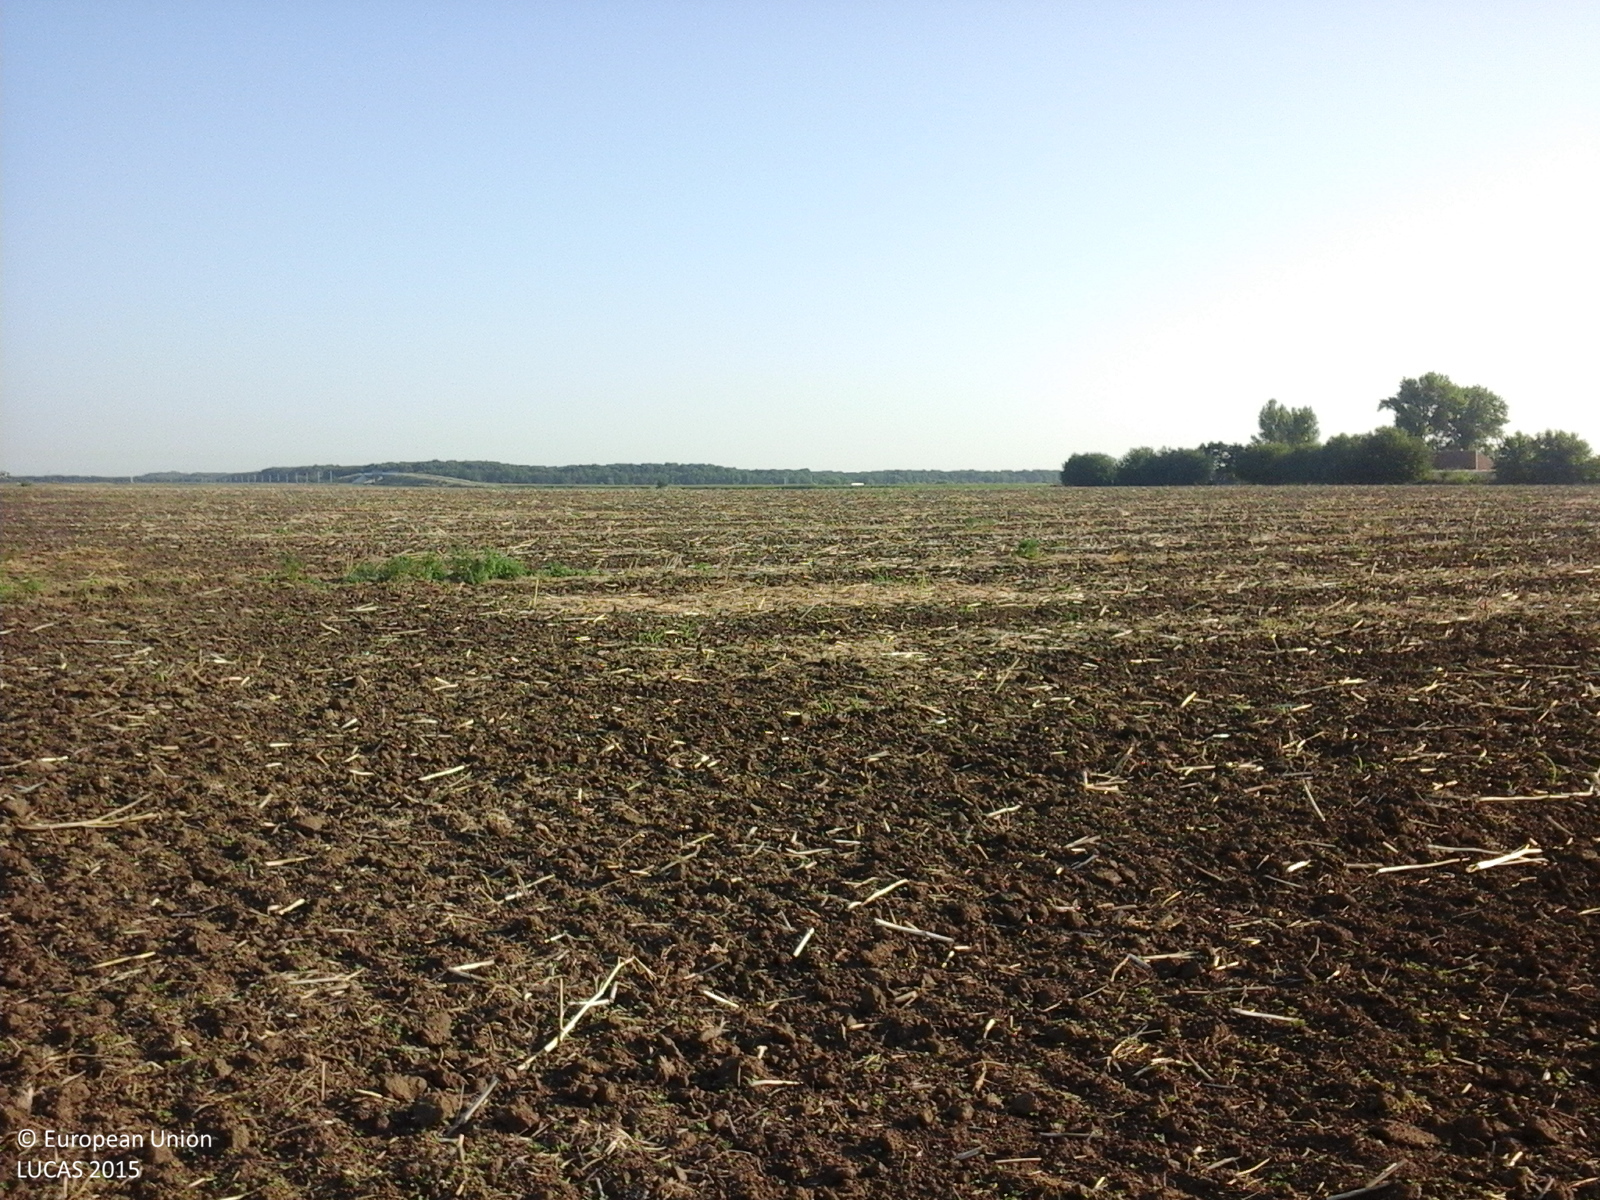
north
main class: Cropland
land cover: Rape and turnip rape
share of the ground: < 10 %
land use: Agriculture (excluding fallow land and kitchen gardens)
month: July
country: RO
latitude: 44.3874
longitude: 27.5540
